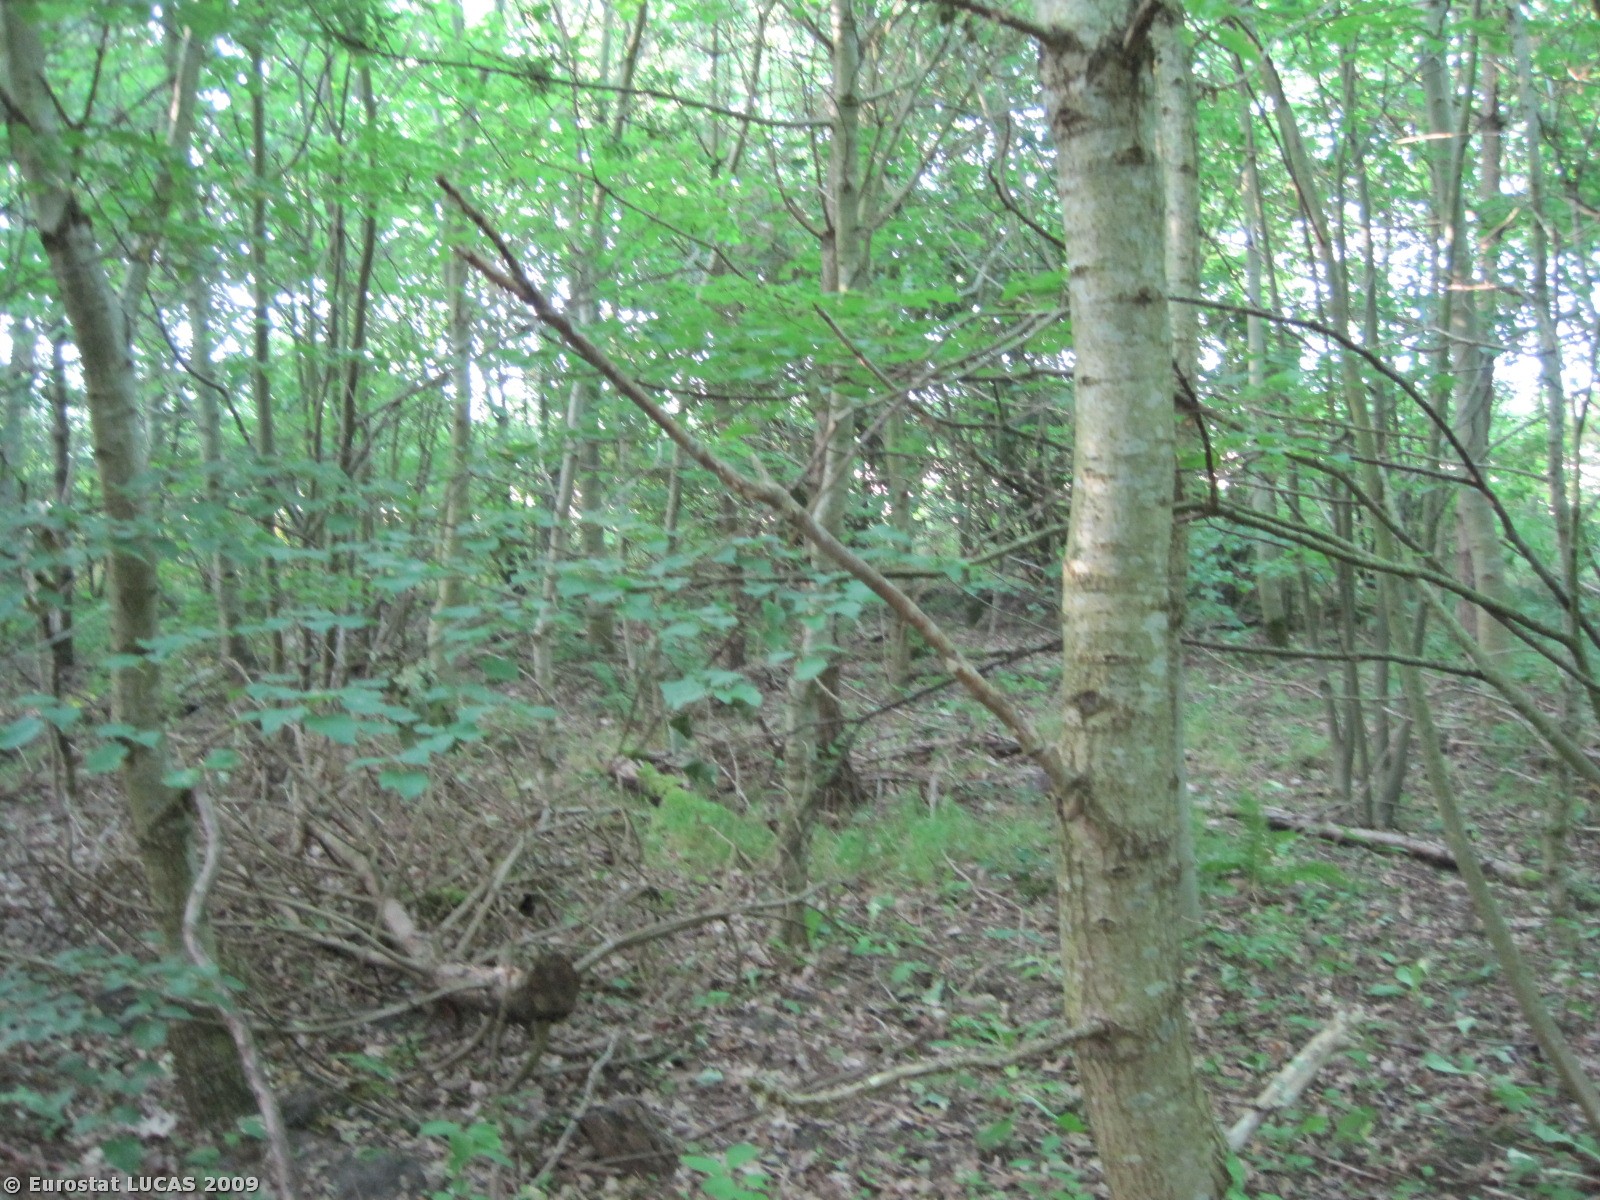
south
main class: Woodland
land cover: Broadleaved woodland
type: plantations and self-sown exotic forest
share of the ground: > 75 %
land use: Unused
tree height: > 5 m
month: July
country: DK
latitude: 56.3747
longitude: 8.3342
